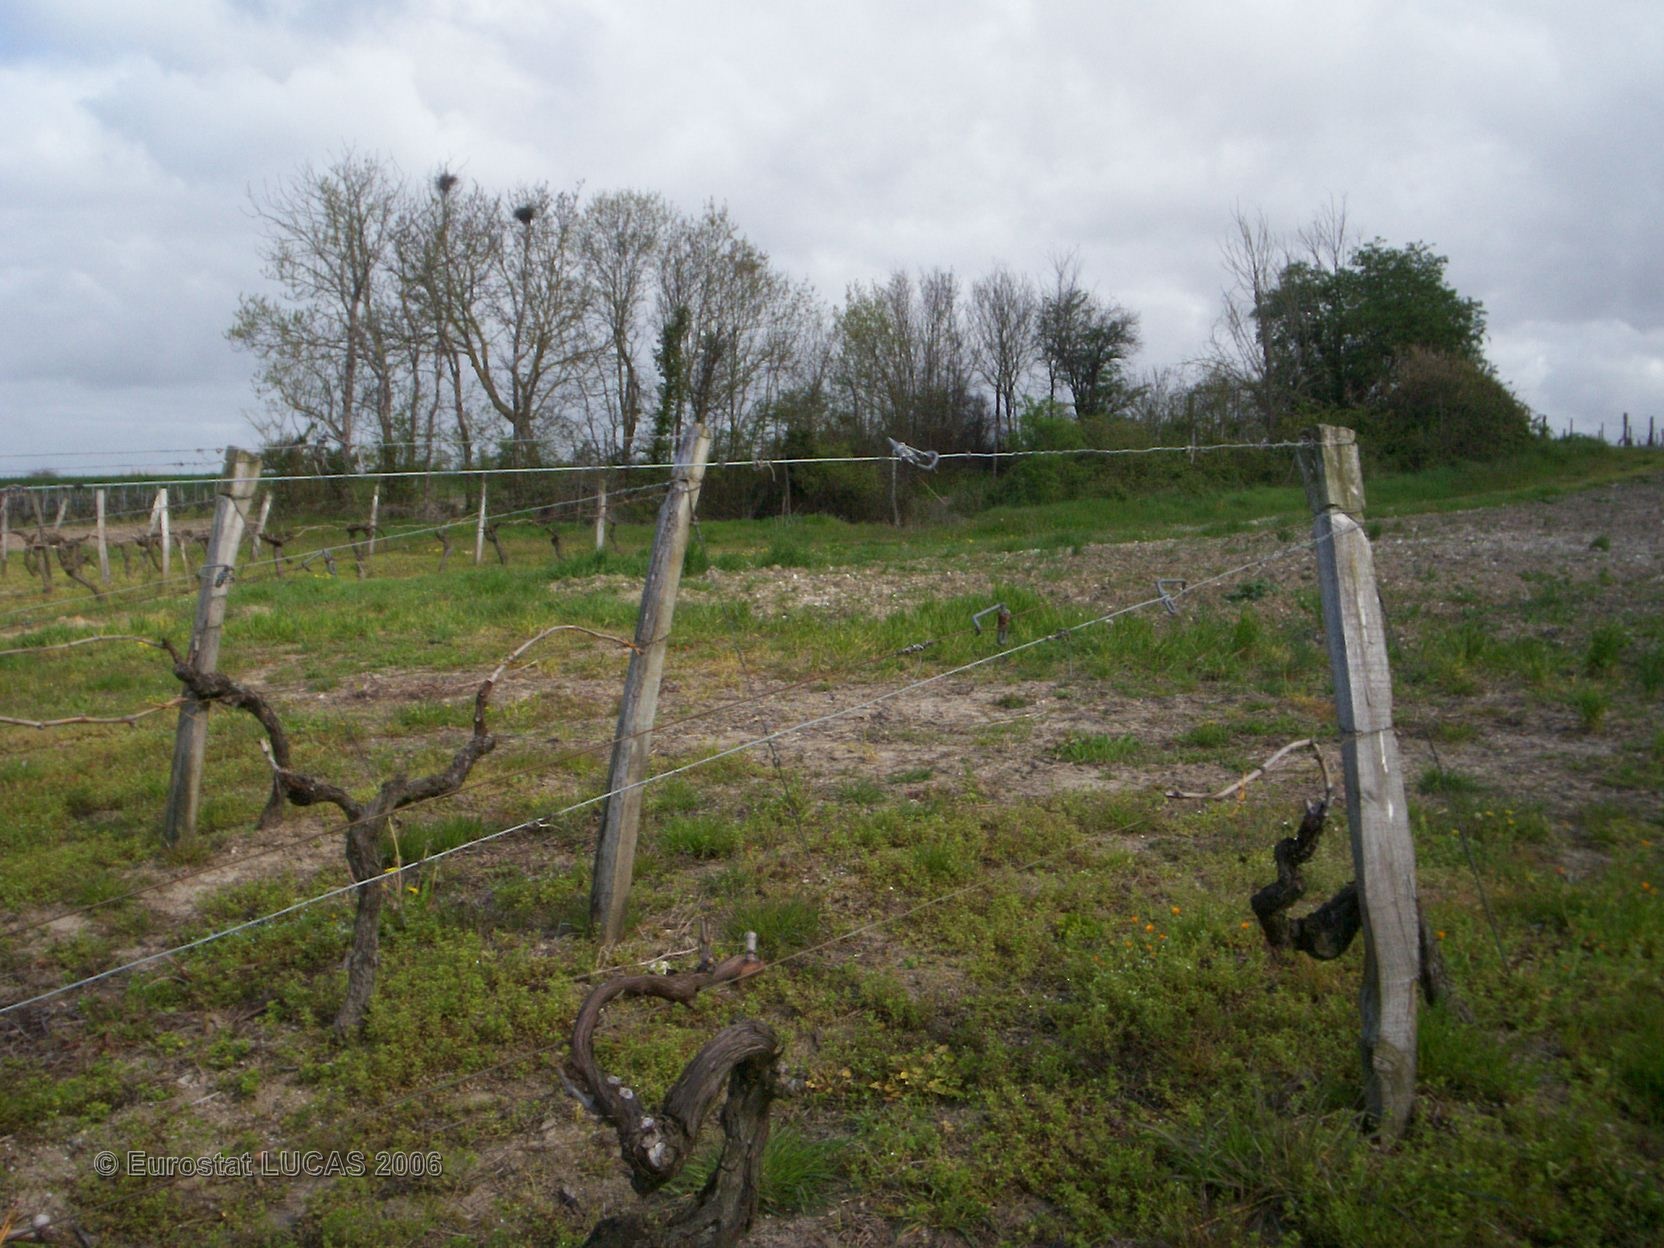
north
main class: Cropland
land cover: Vineyards
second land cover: Grassland with sparse tree/shrub cover
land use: Agriculture (excluding fallow land and kitchen gardens)
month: April
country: FR
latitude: 45.4292
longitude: -0.7216
